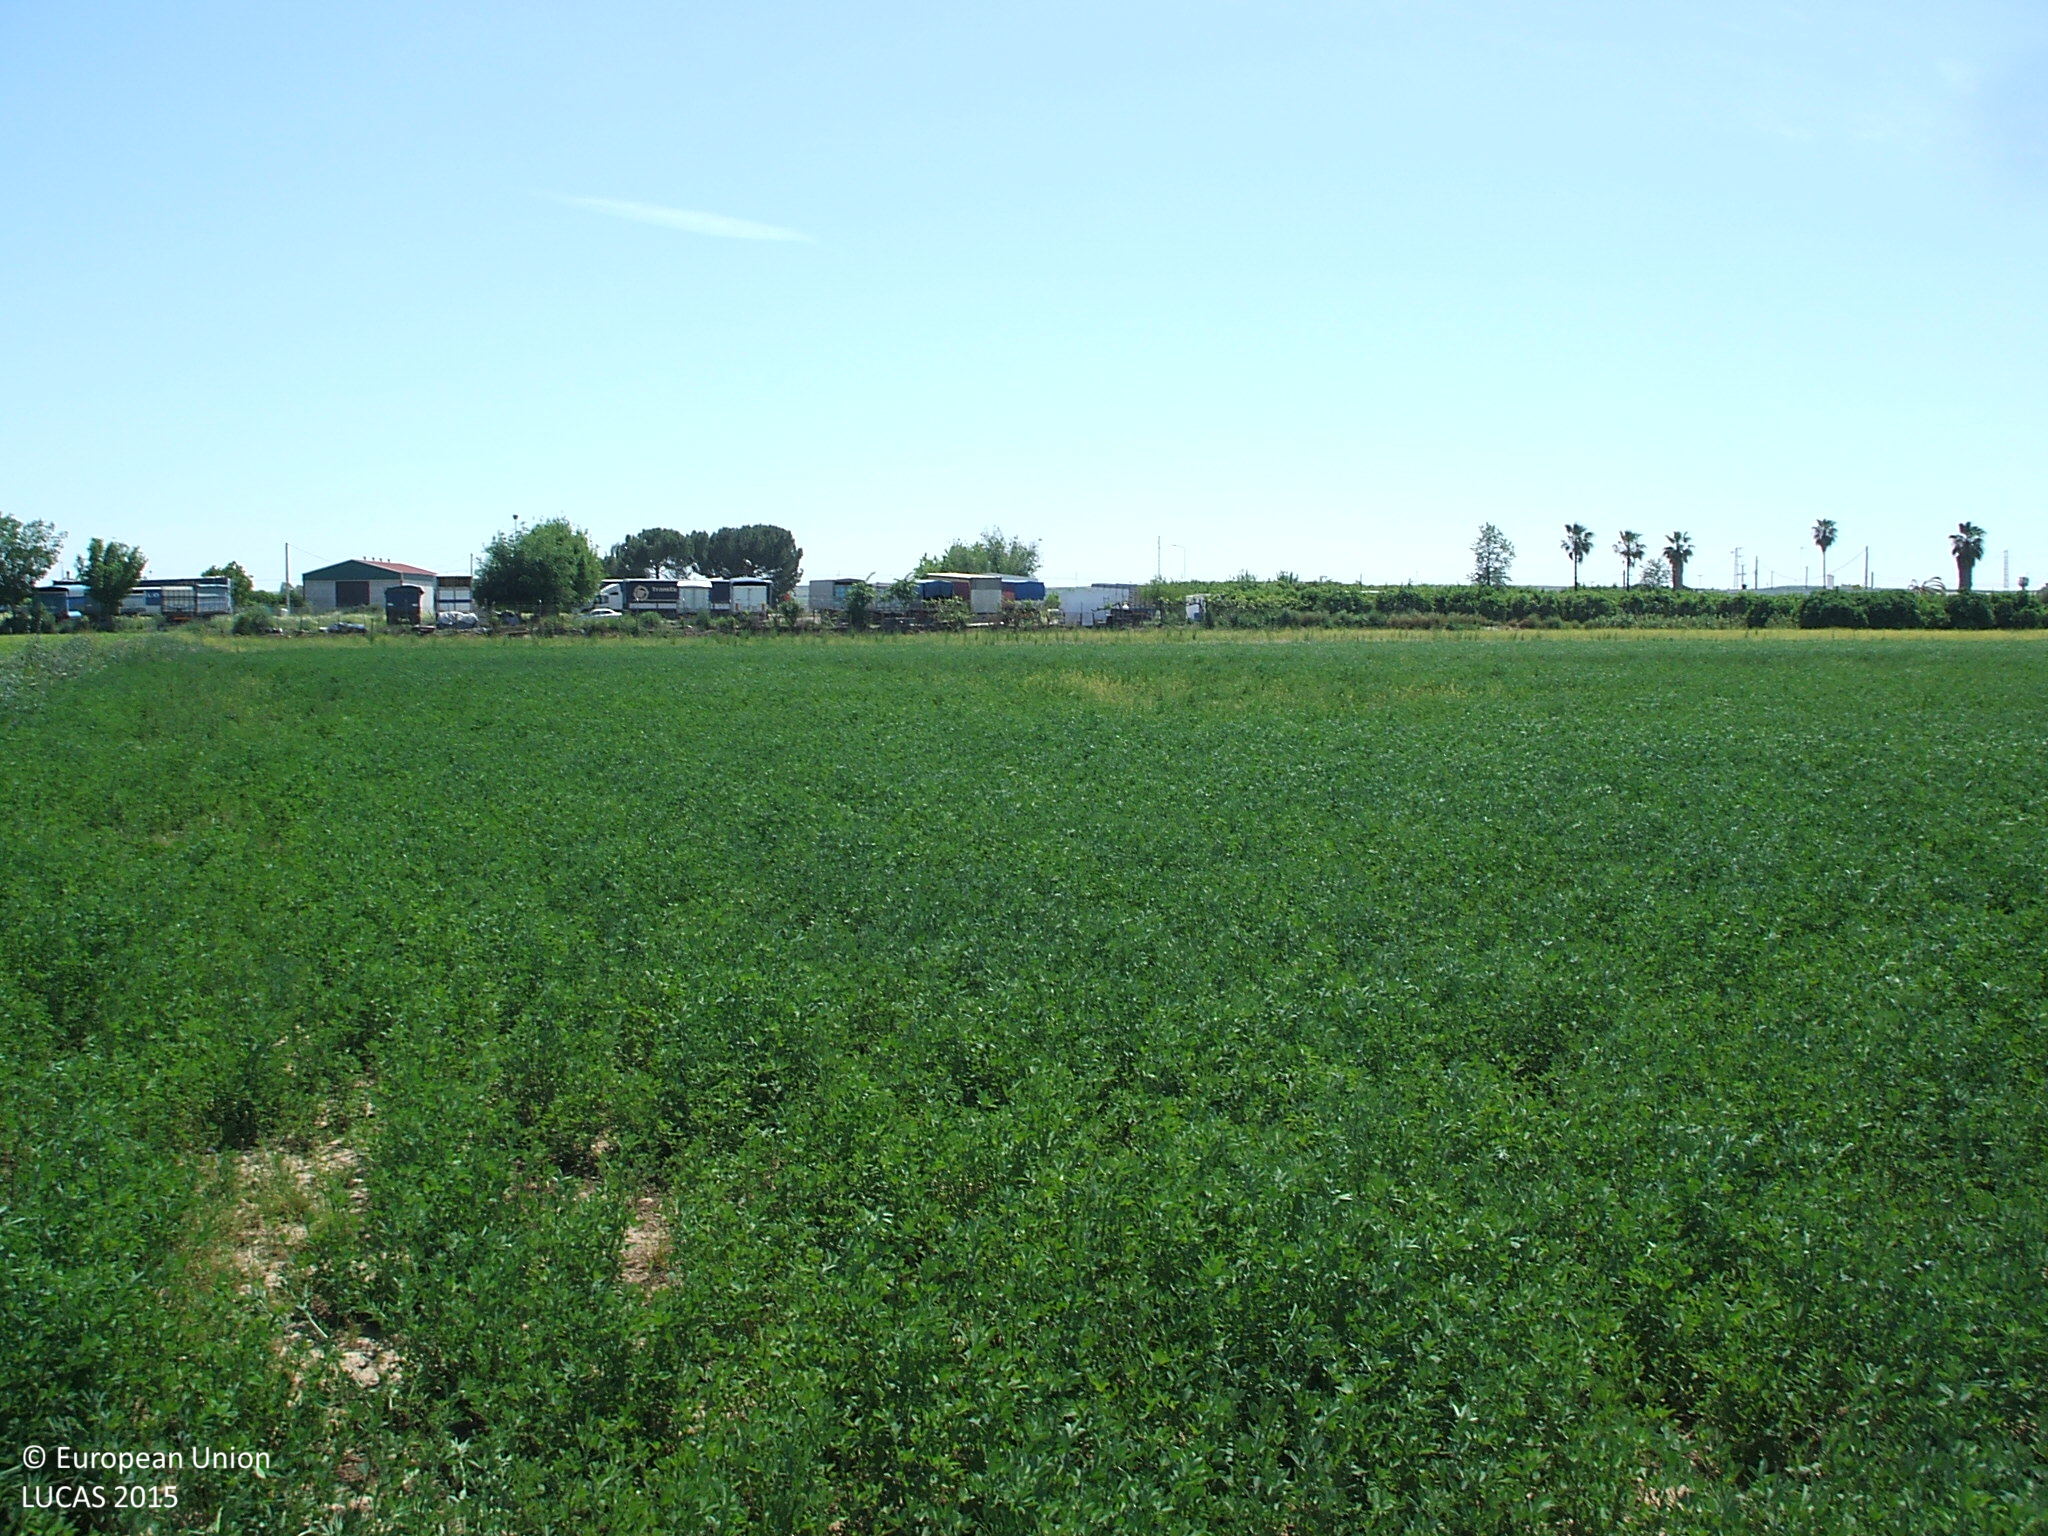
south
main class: Cropland
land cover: Maize
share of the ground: 50 - 75 %
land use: Agriculture (excluding fallow land and kitchen gardens)
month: April
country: ES
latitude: 37.6412
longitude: -5.5358
